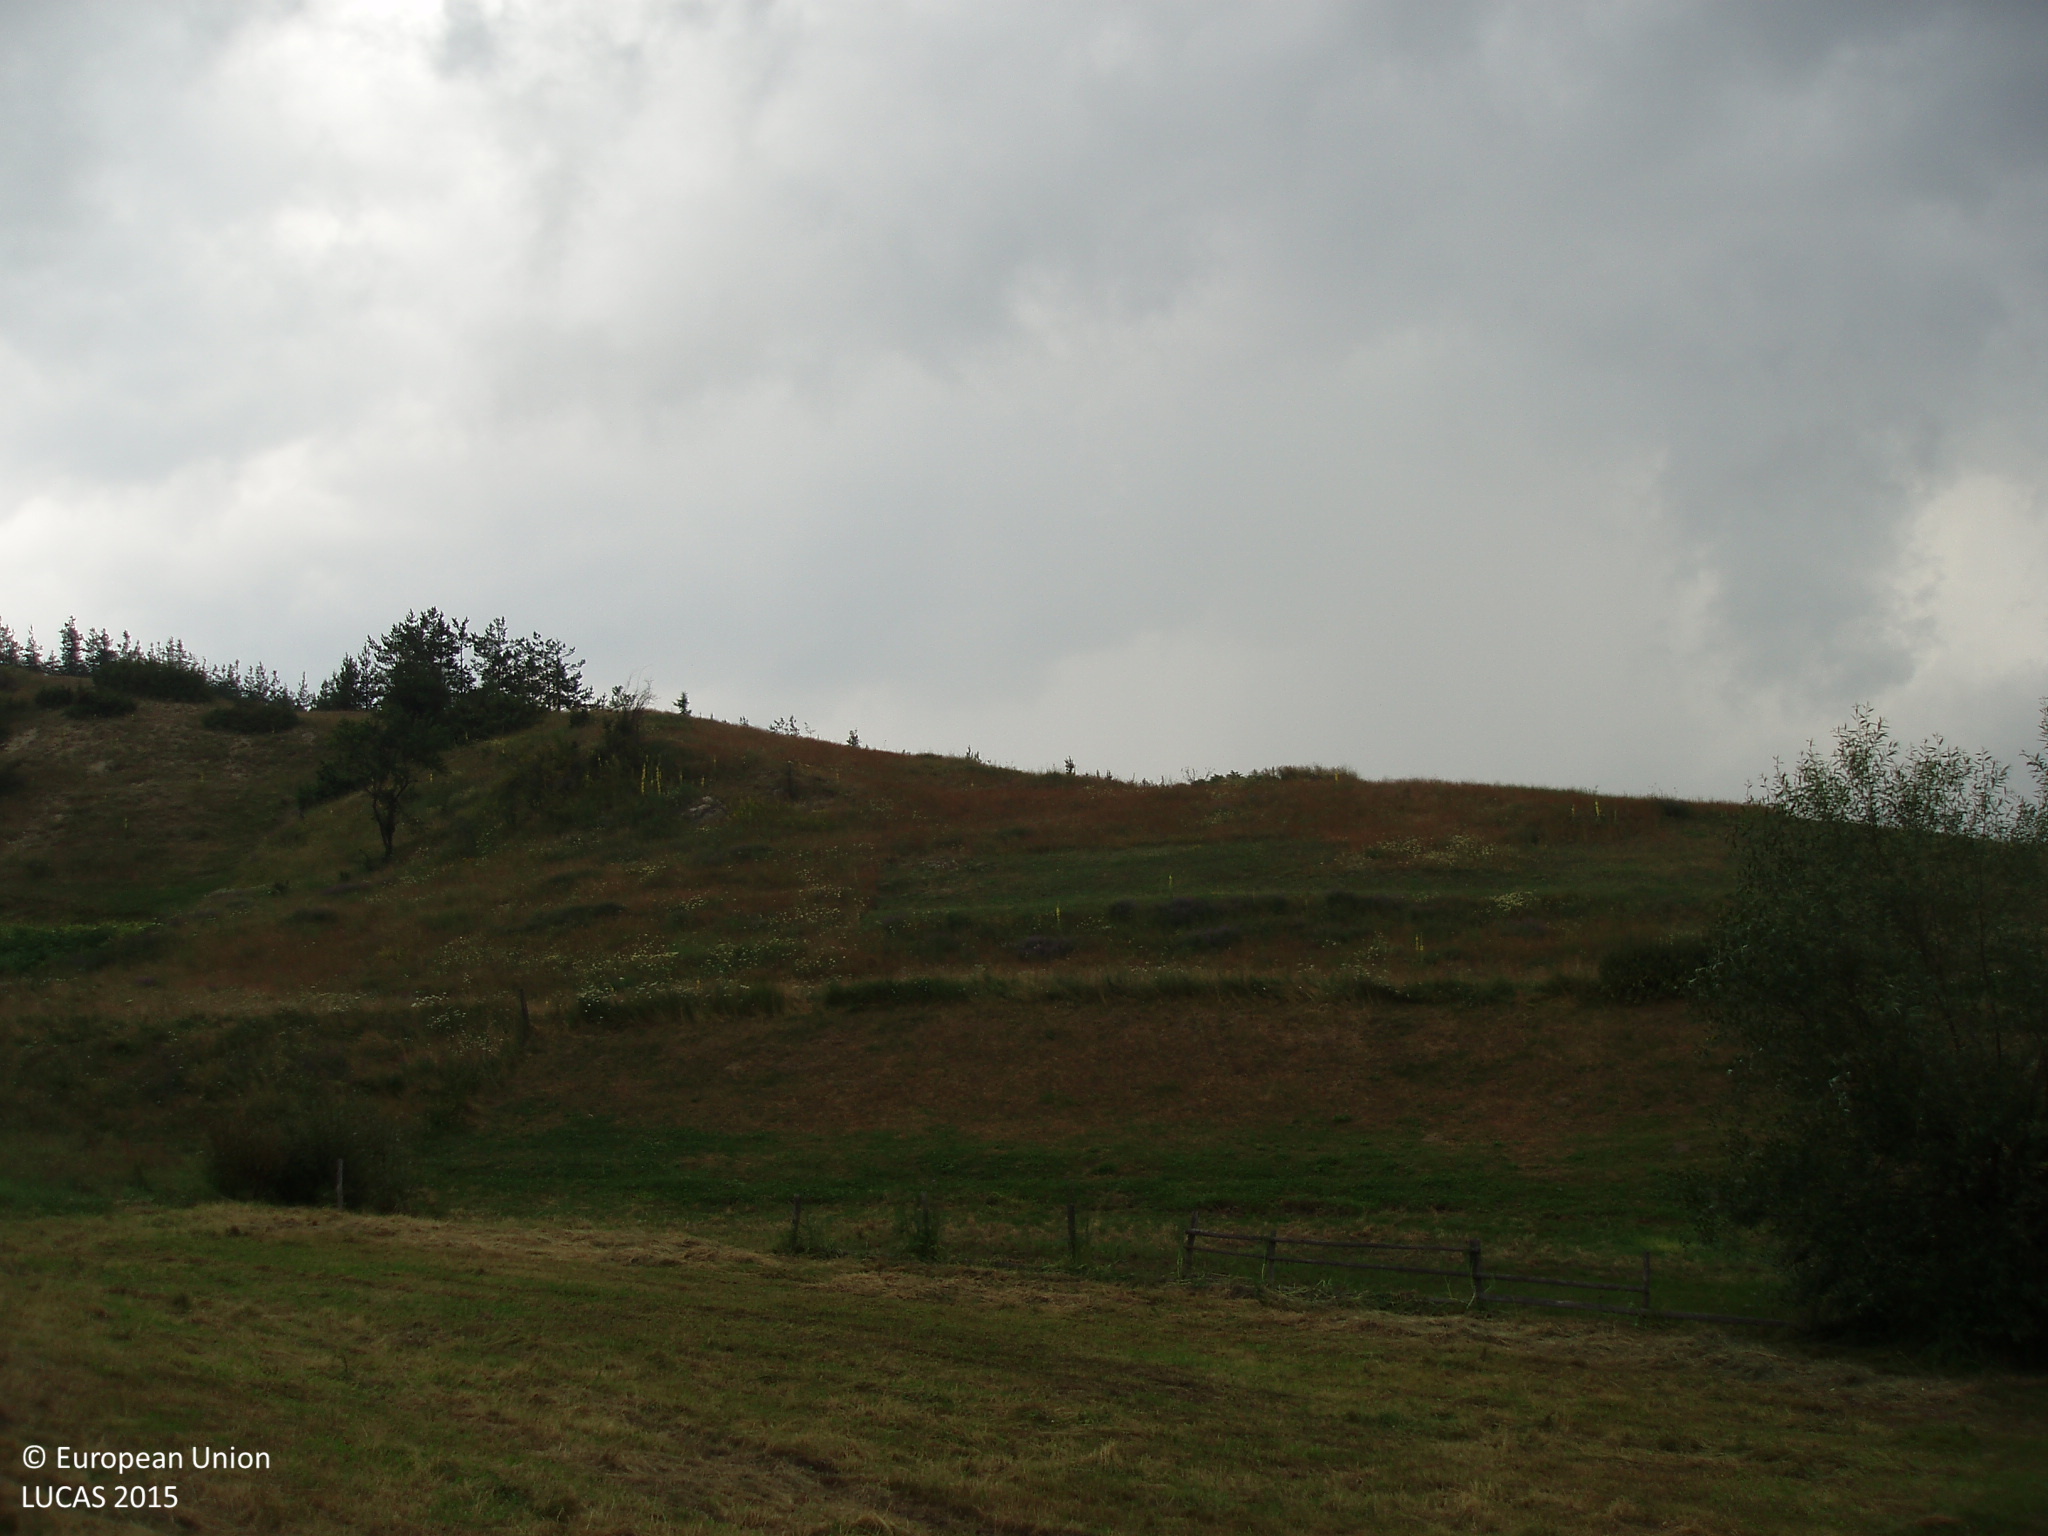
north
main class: Grassland
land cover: Grassland without tree/shrub cover
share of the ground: > 75 %
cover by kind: herbaceous plants 100 %
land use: Agriculture (excluding fallow land and kitchen gardens)
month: July
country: BG
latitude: 42.0057
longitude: 23.7370
